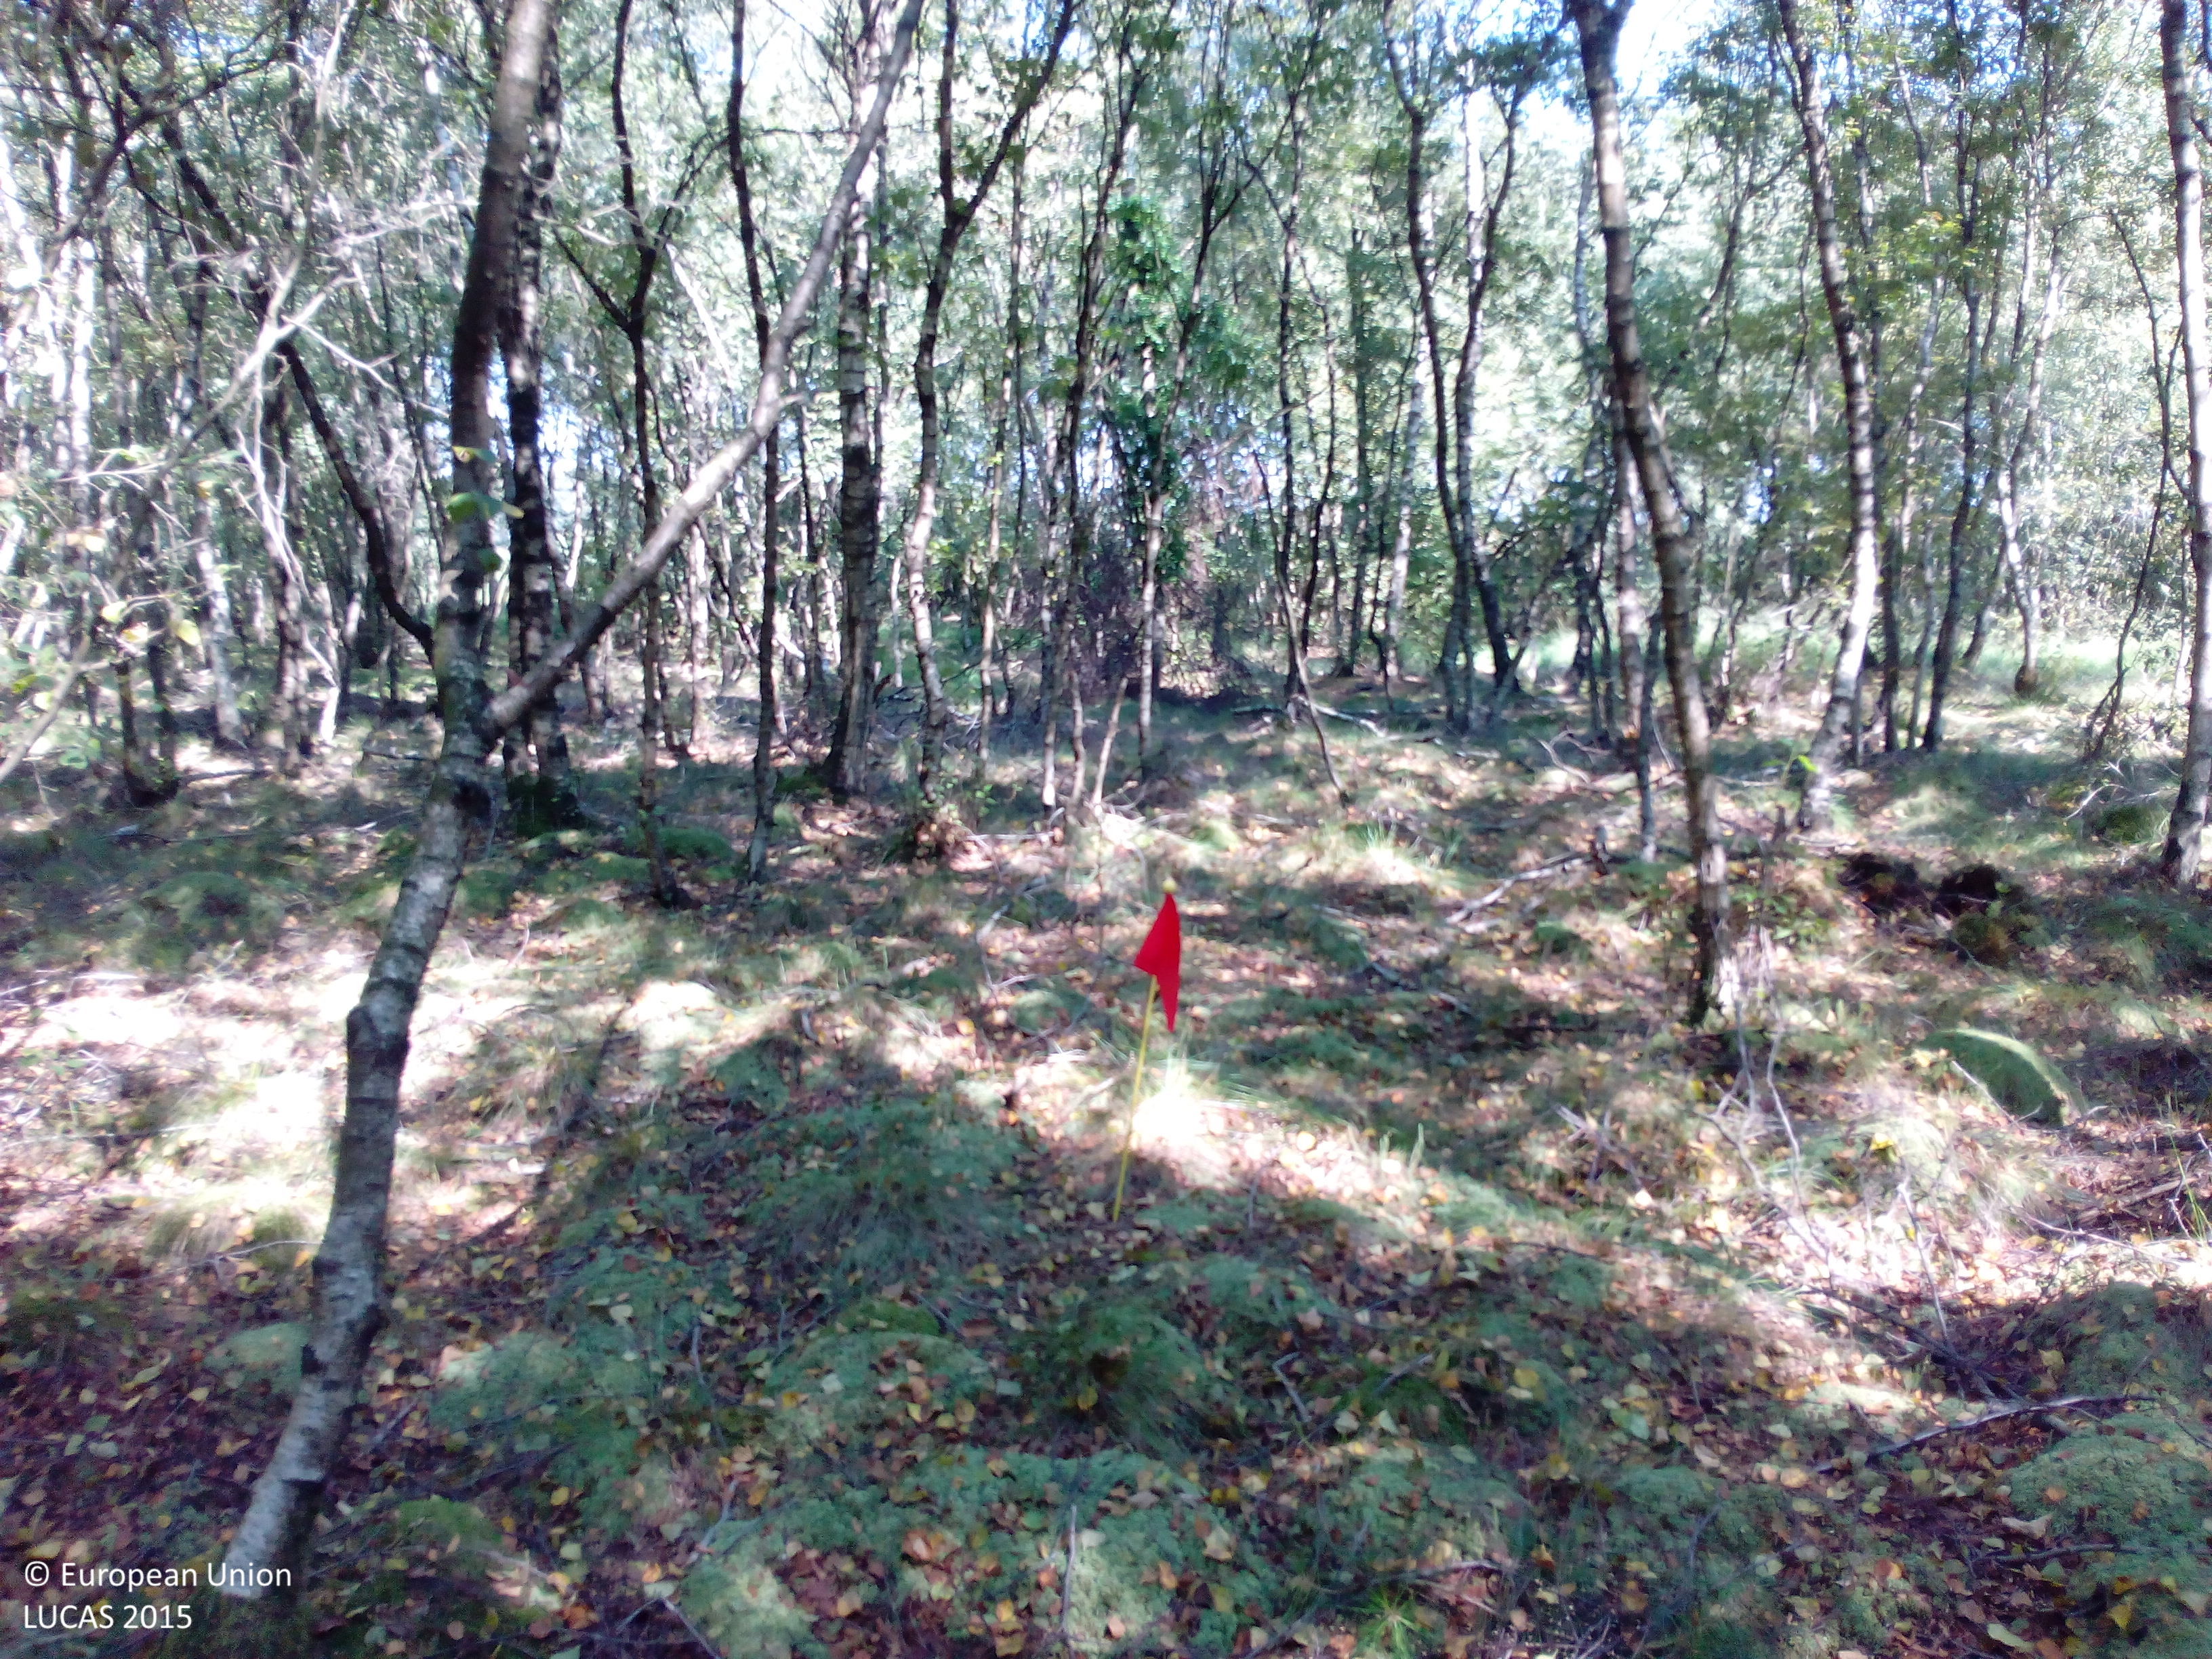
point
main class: Woodland
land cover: Broadleaved woodland
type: non-riverine alder, birch or aspen forest
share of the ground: > 75 %
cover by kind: broadleaved forest trees 80 %, herbaceous plants 10 %, shrubs 5 %, lichens and mosses 5 %
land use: Forestry
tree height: > 5 m
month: August
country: DE
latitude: 52.7921
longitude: 7.9986
